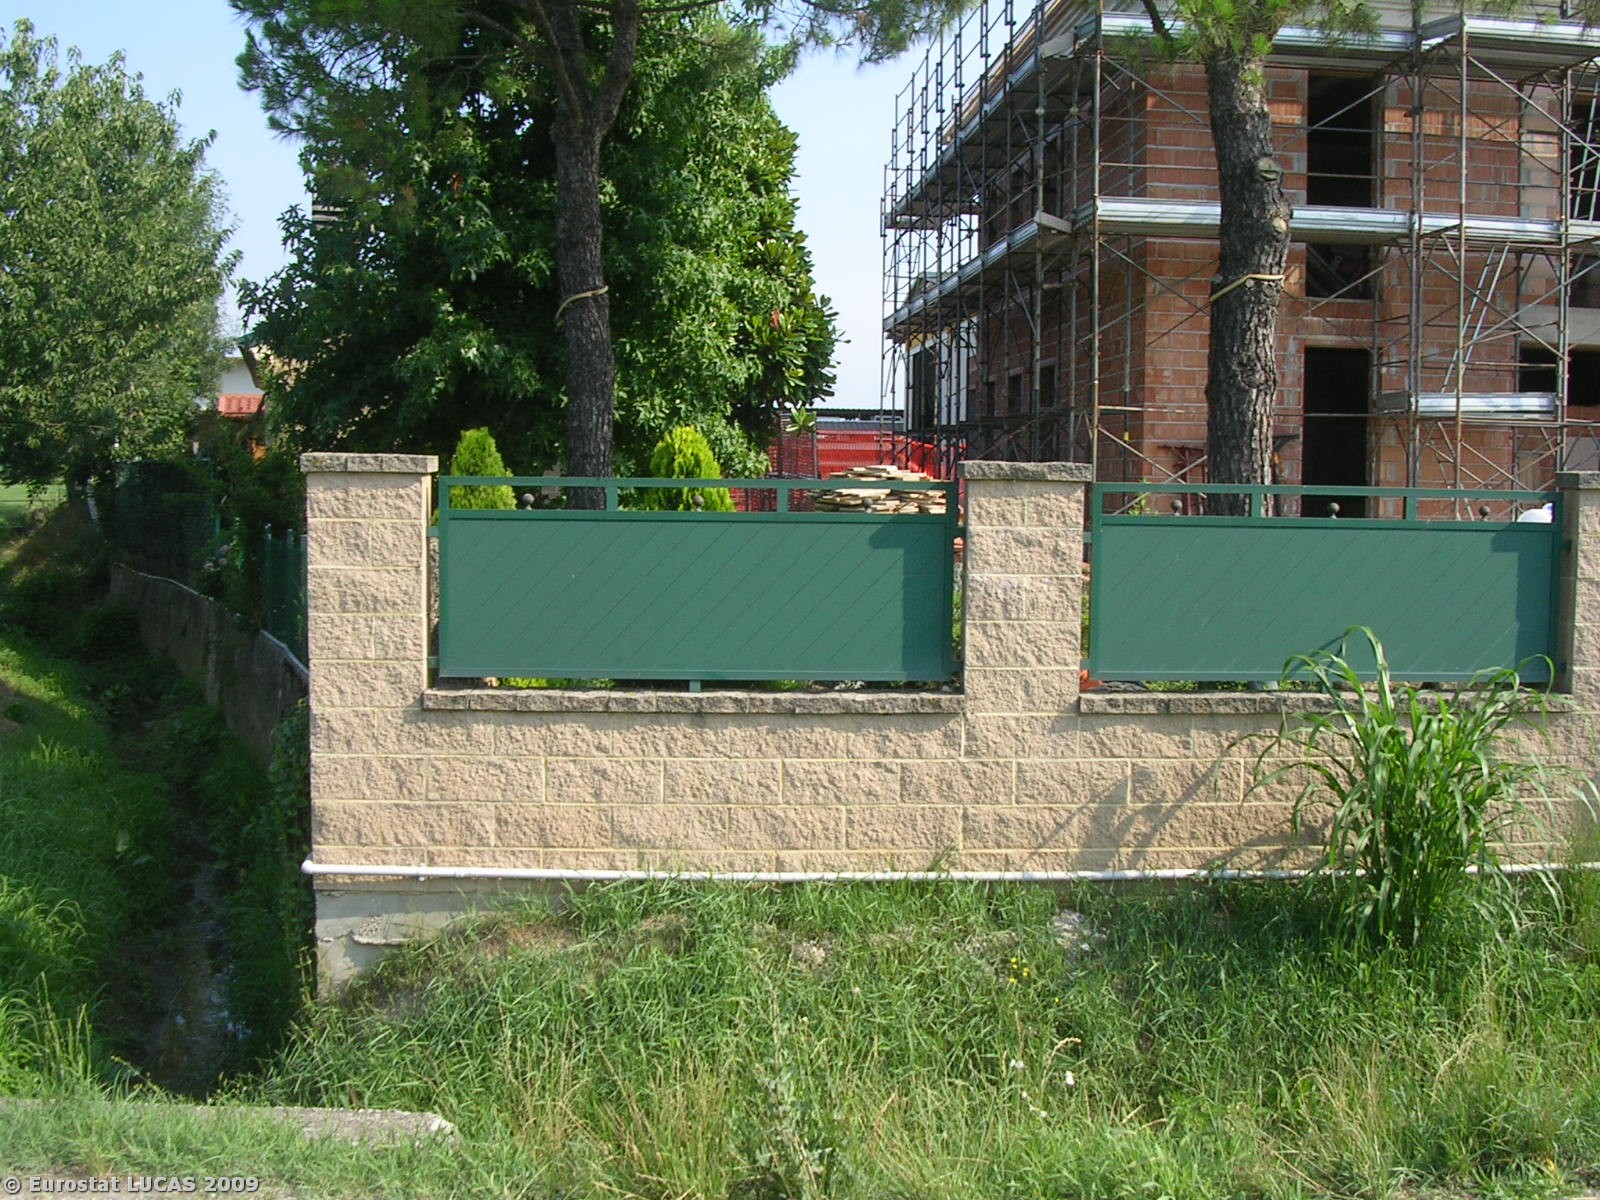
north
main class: Cropland
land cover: Nuts trees
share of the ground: 50 - 75 %
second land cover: Grassland with sparse tree/shrub cover
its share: 50 - 75 %
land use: Agriculture (excluding fallow land and kitchen gardens)
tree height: < 5 m
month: July
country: IT
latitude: 45.5440
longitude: 11.7518
